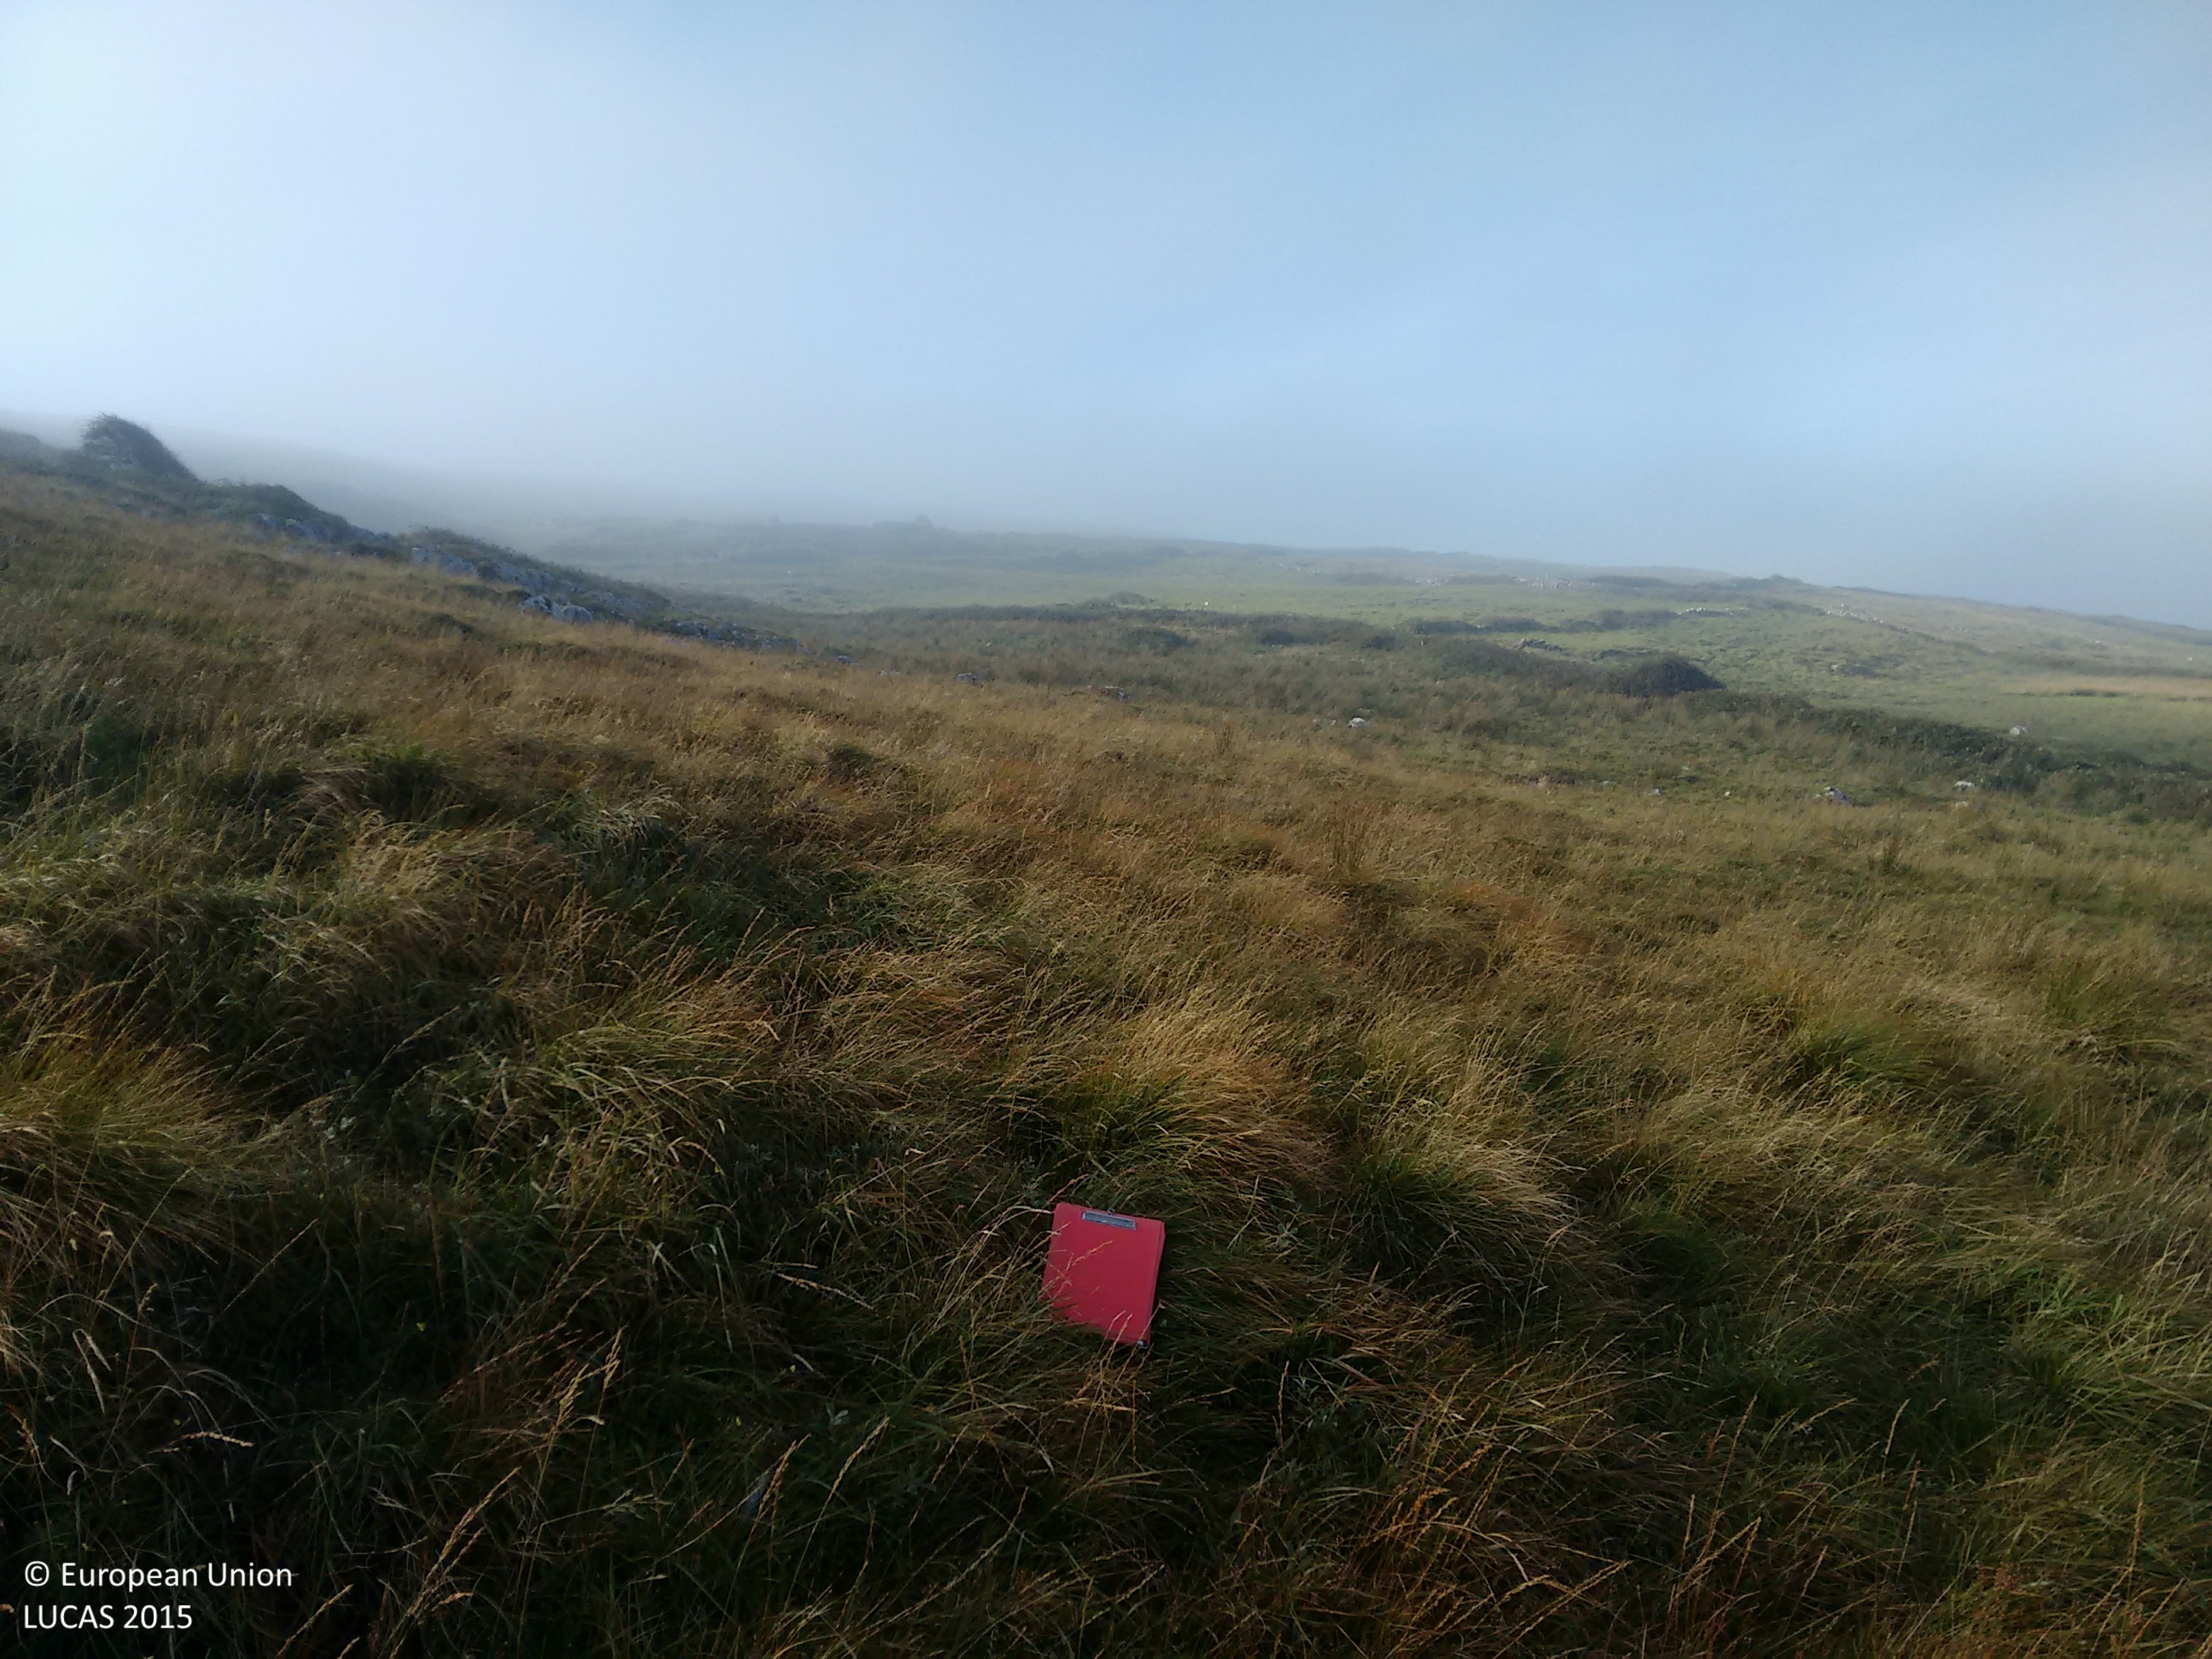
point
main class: Grassland
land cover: Grassland without tree/shrub cover
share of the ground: > 75 %
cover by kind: herbaceous plants 100 %
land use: Agriculture (excluding fallow land and kitchen gardens)
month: September
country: IE
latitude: 53.0878
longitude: -9.2912
